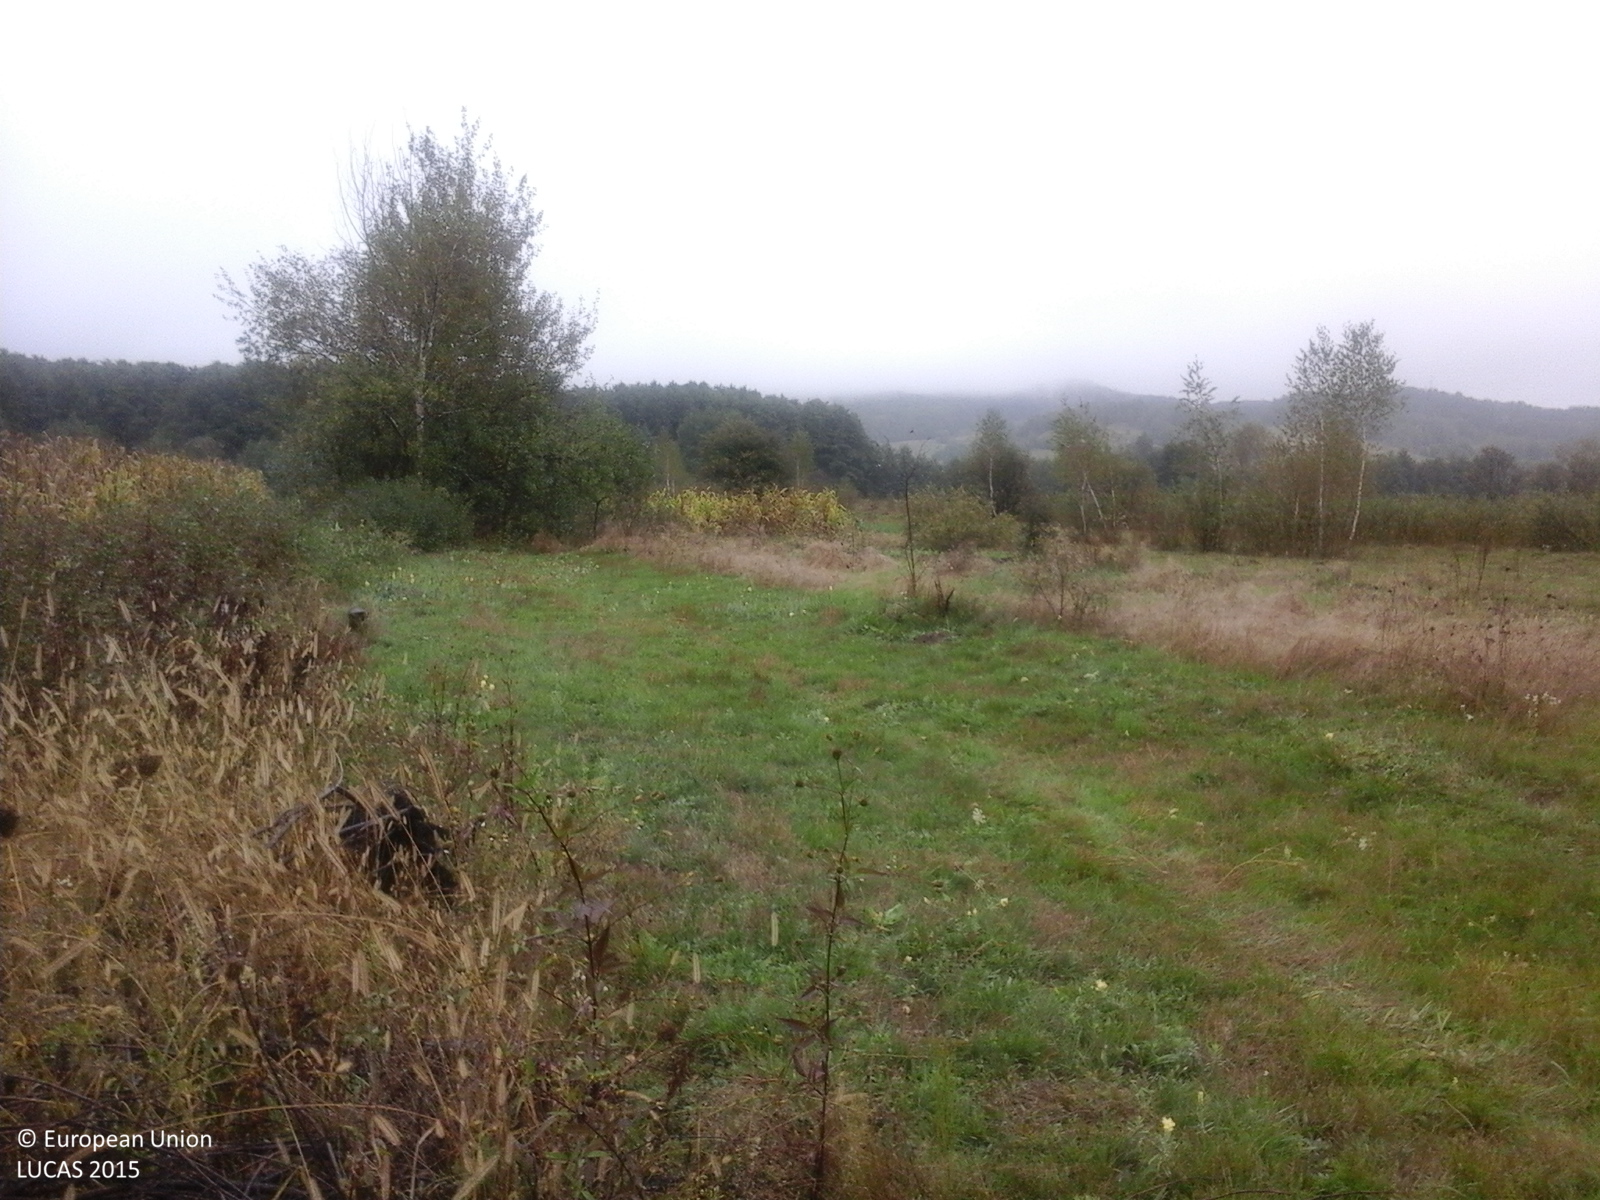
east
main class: Grassland
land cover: Spontaneously vegetated surfaces
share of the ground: > 75 %
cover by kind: herbaceous plants 100 %
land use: Agriculture (excluding fallow land and kitchen gardens)
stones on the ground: < 10 %
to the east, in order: Spontaneously vegetated surfaces; Grassland without tree/shrub cover; Grassland with sparse tree/shrub cover; Grassland without tree/shrub cover
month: September
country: RO
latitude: 45.1363
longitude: 23.8356
